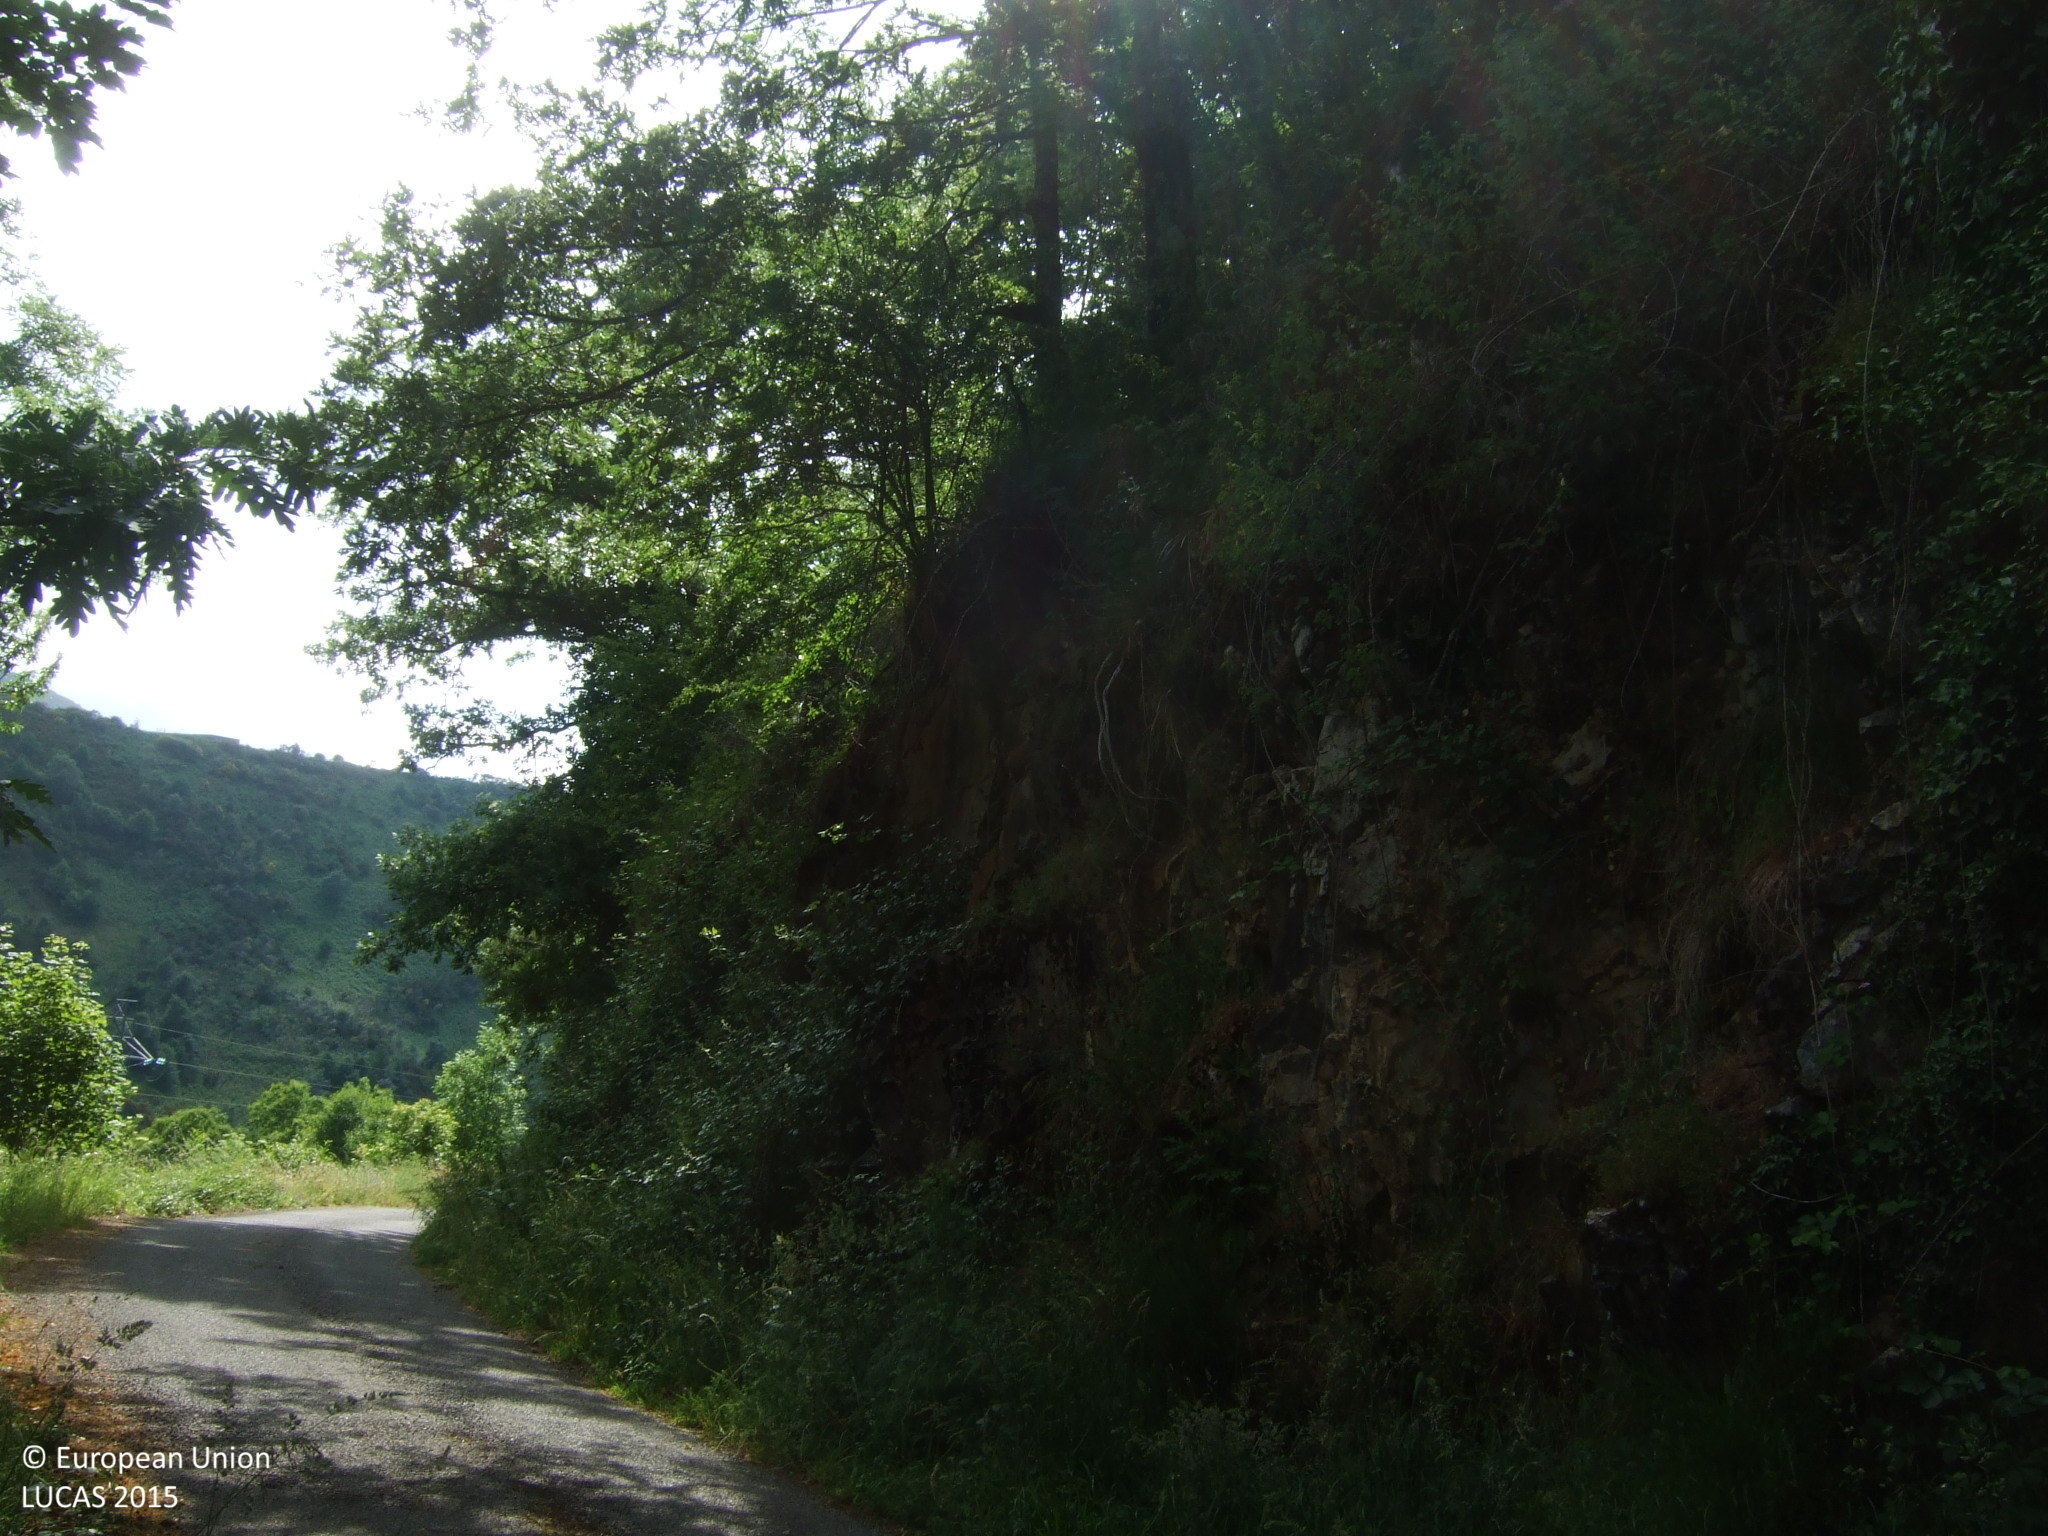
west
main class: Woodland
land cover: Broadleaved woodland
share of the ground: 50 - 75 %
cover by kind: broadleaved forest trees 65 %, shrubs 35 %
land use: Semi-natural and natural areas not in use
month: June
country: ES
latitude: 42.6505
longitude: -7.0507
